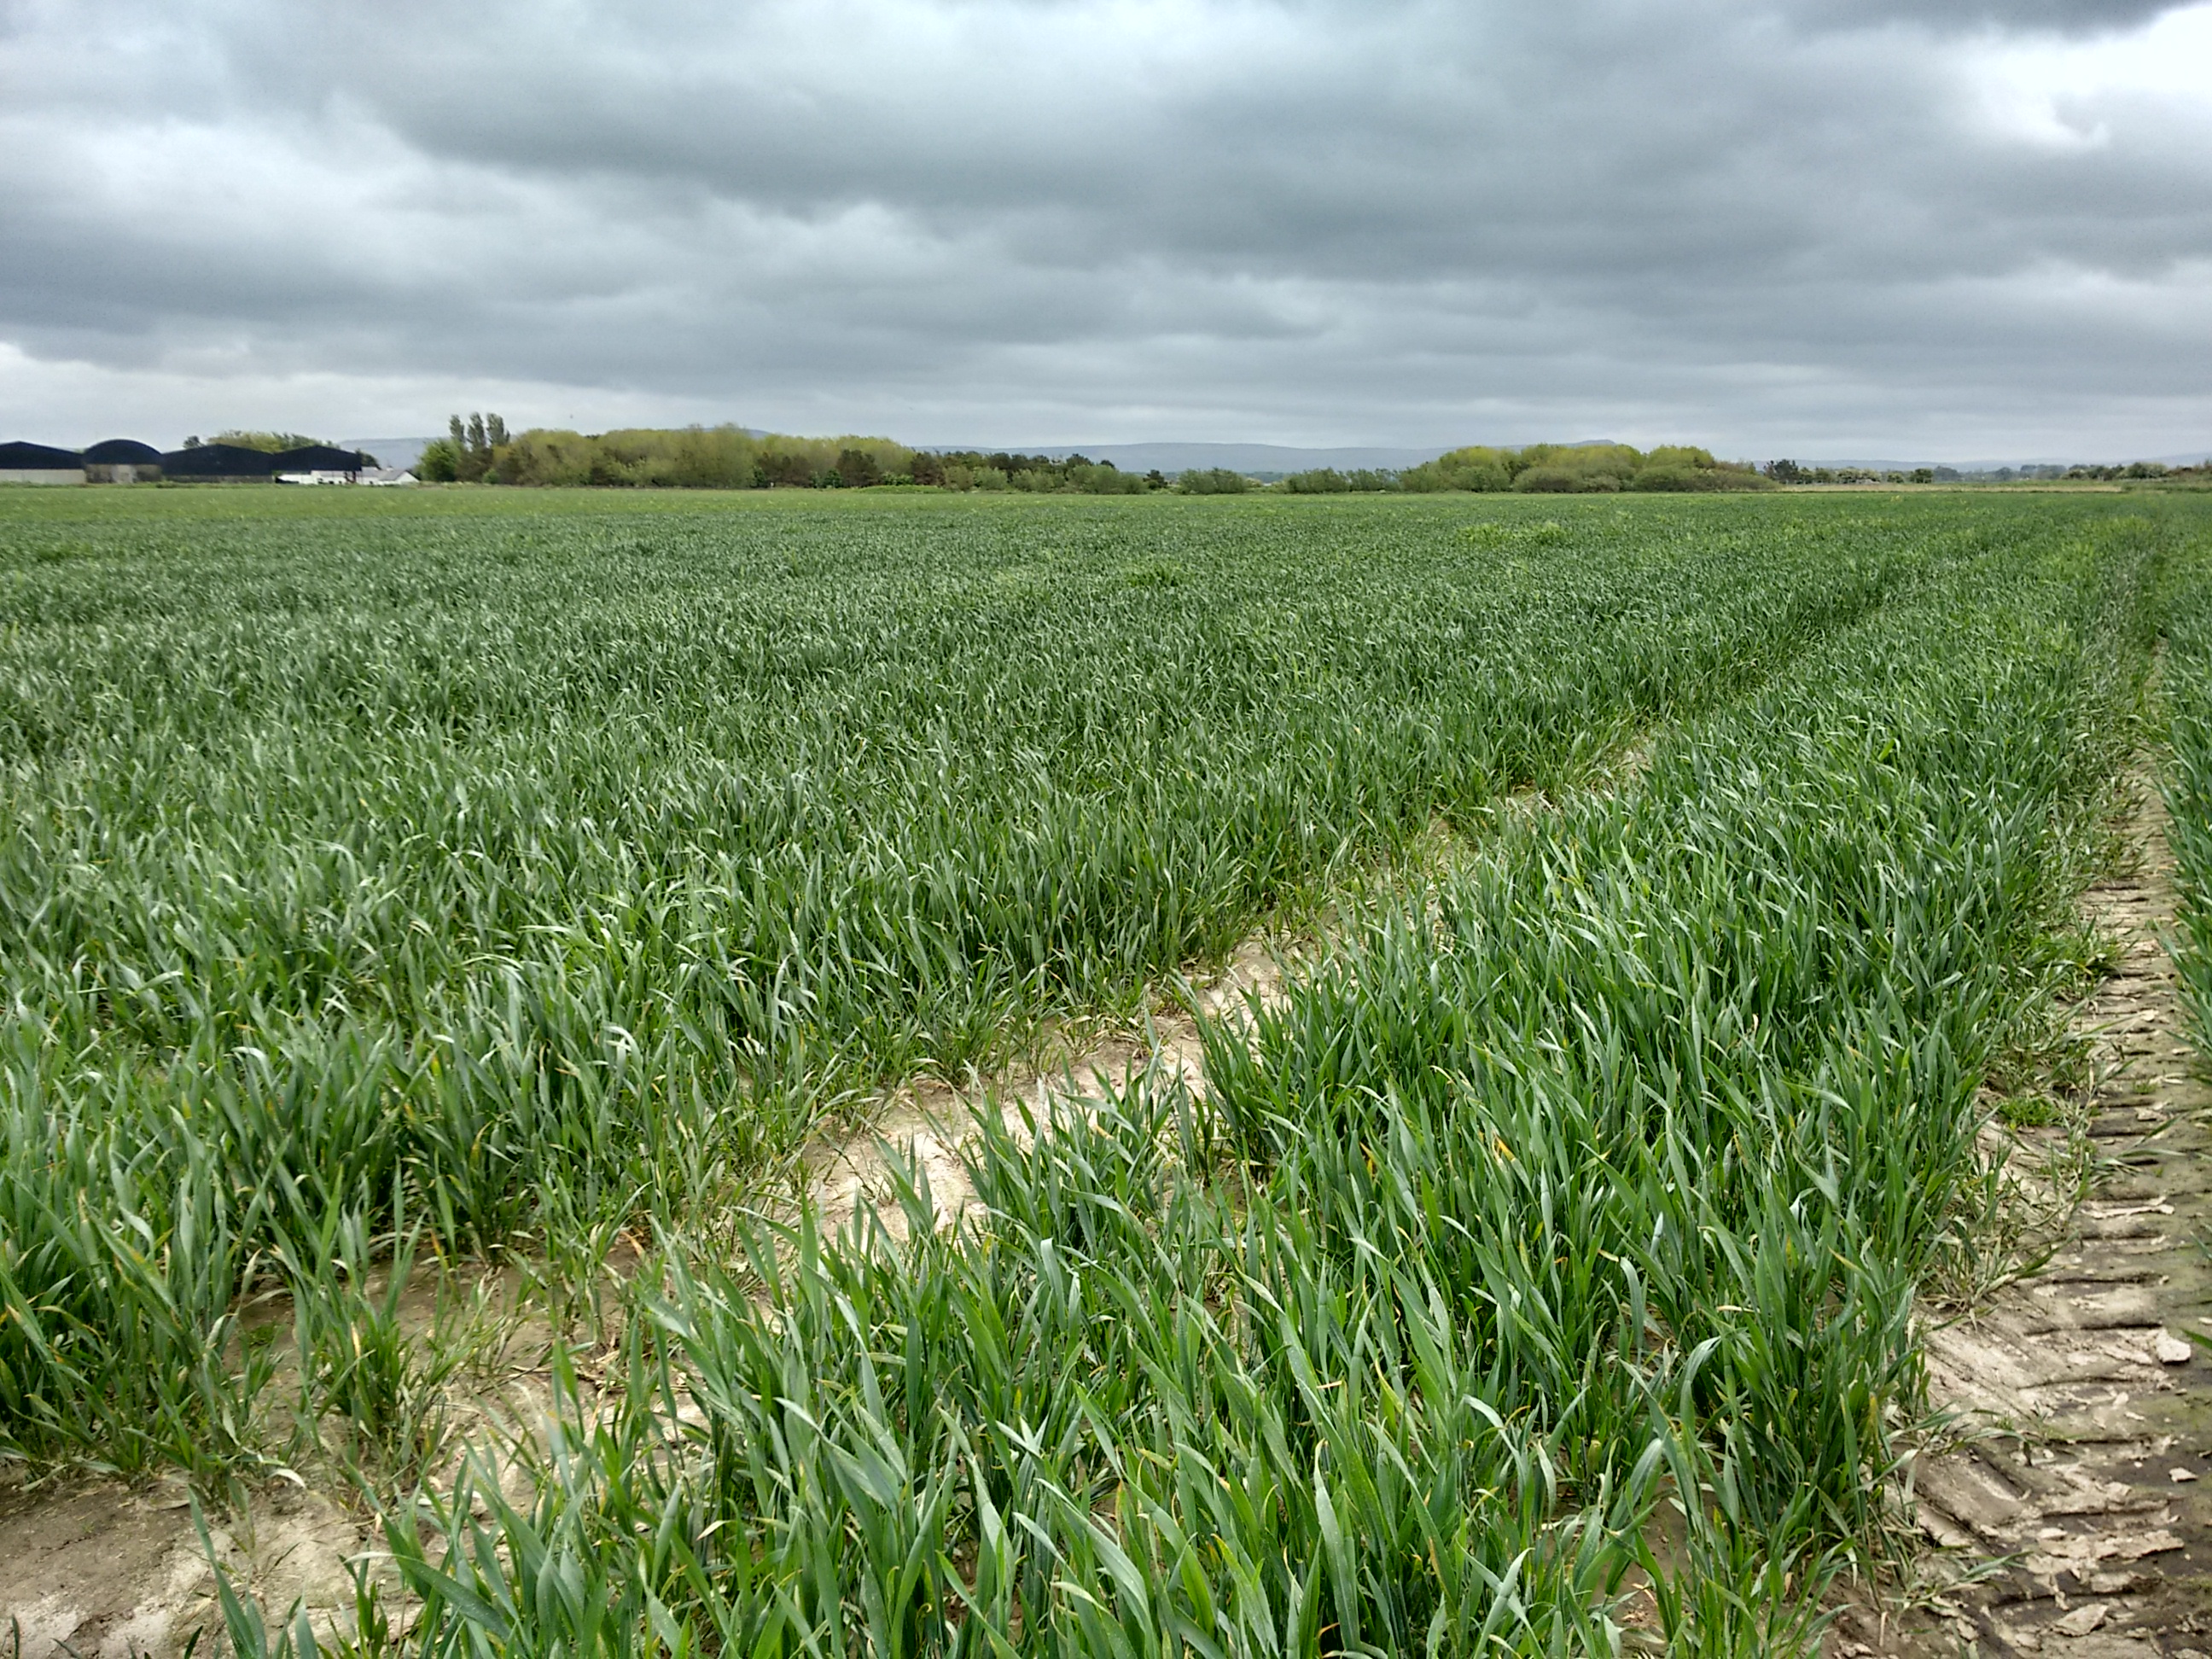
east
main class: Cropland
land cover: Common wheat
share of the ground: > 75 %
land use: Agriculture (excluding fallow land and kitchen gardens)
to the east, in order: Common wheat
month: May
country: GB
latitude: 55.0764
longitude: -7.0066
